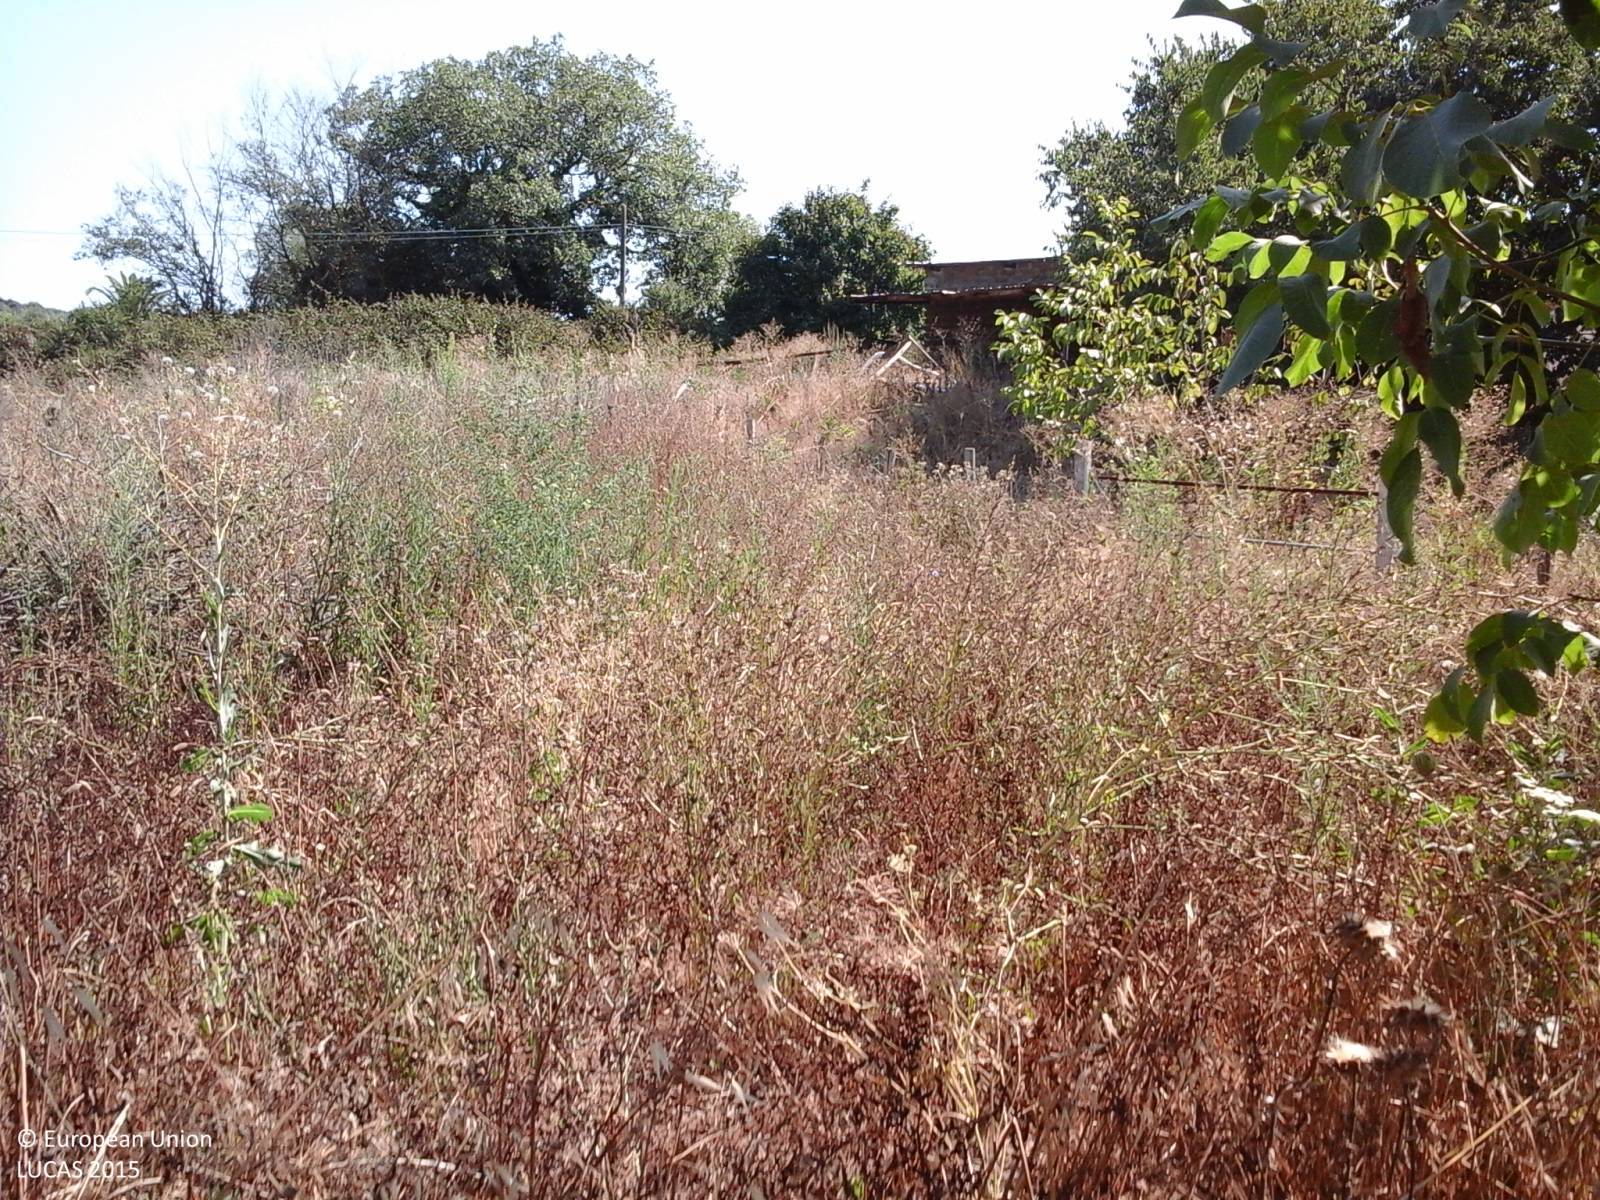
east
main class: Grassland
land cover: Grassland with sparse tree/shrub cover
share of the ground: > 75 %
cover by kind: herbaceous plants 95 %, broadleaved forest trees 5 %
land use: Agriculture (excluding fallow land and kitchen gardens)
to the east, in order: Grassland with sparse tree/shrub cover; Single bushes/trees; Artificial constructions in urban areas; Grassland with sparse tree/shrub cover; Fences; Tracks; Grass margins; Broadleaved woodland; Ditches and canals; Managed hedges; Shrubland with sparse tree cover; Abandoned hedges; Grassland without tree/shrub cover; Abandoned hedges; Mixed cereals for fodder
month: August
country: IT
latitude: 42.1585
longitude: 12.2793
